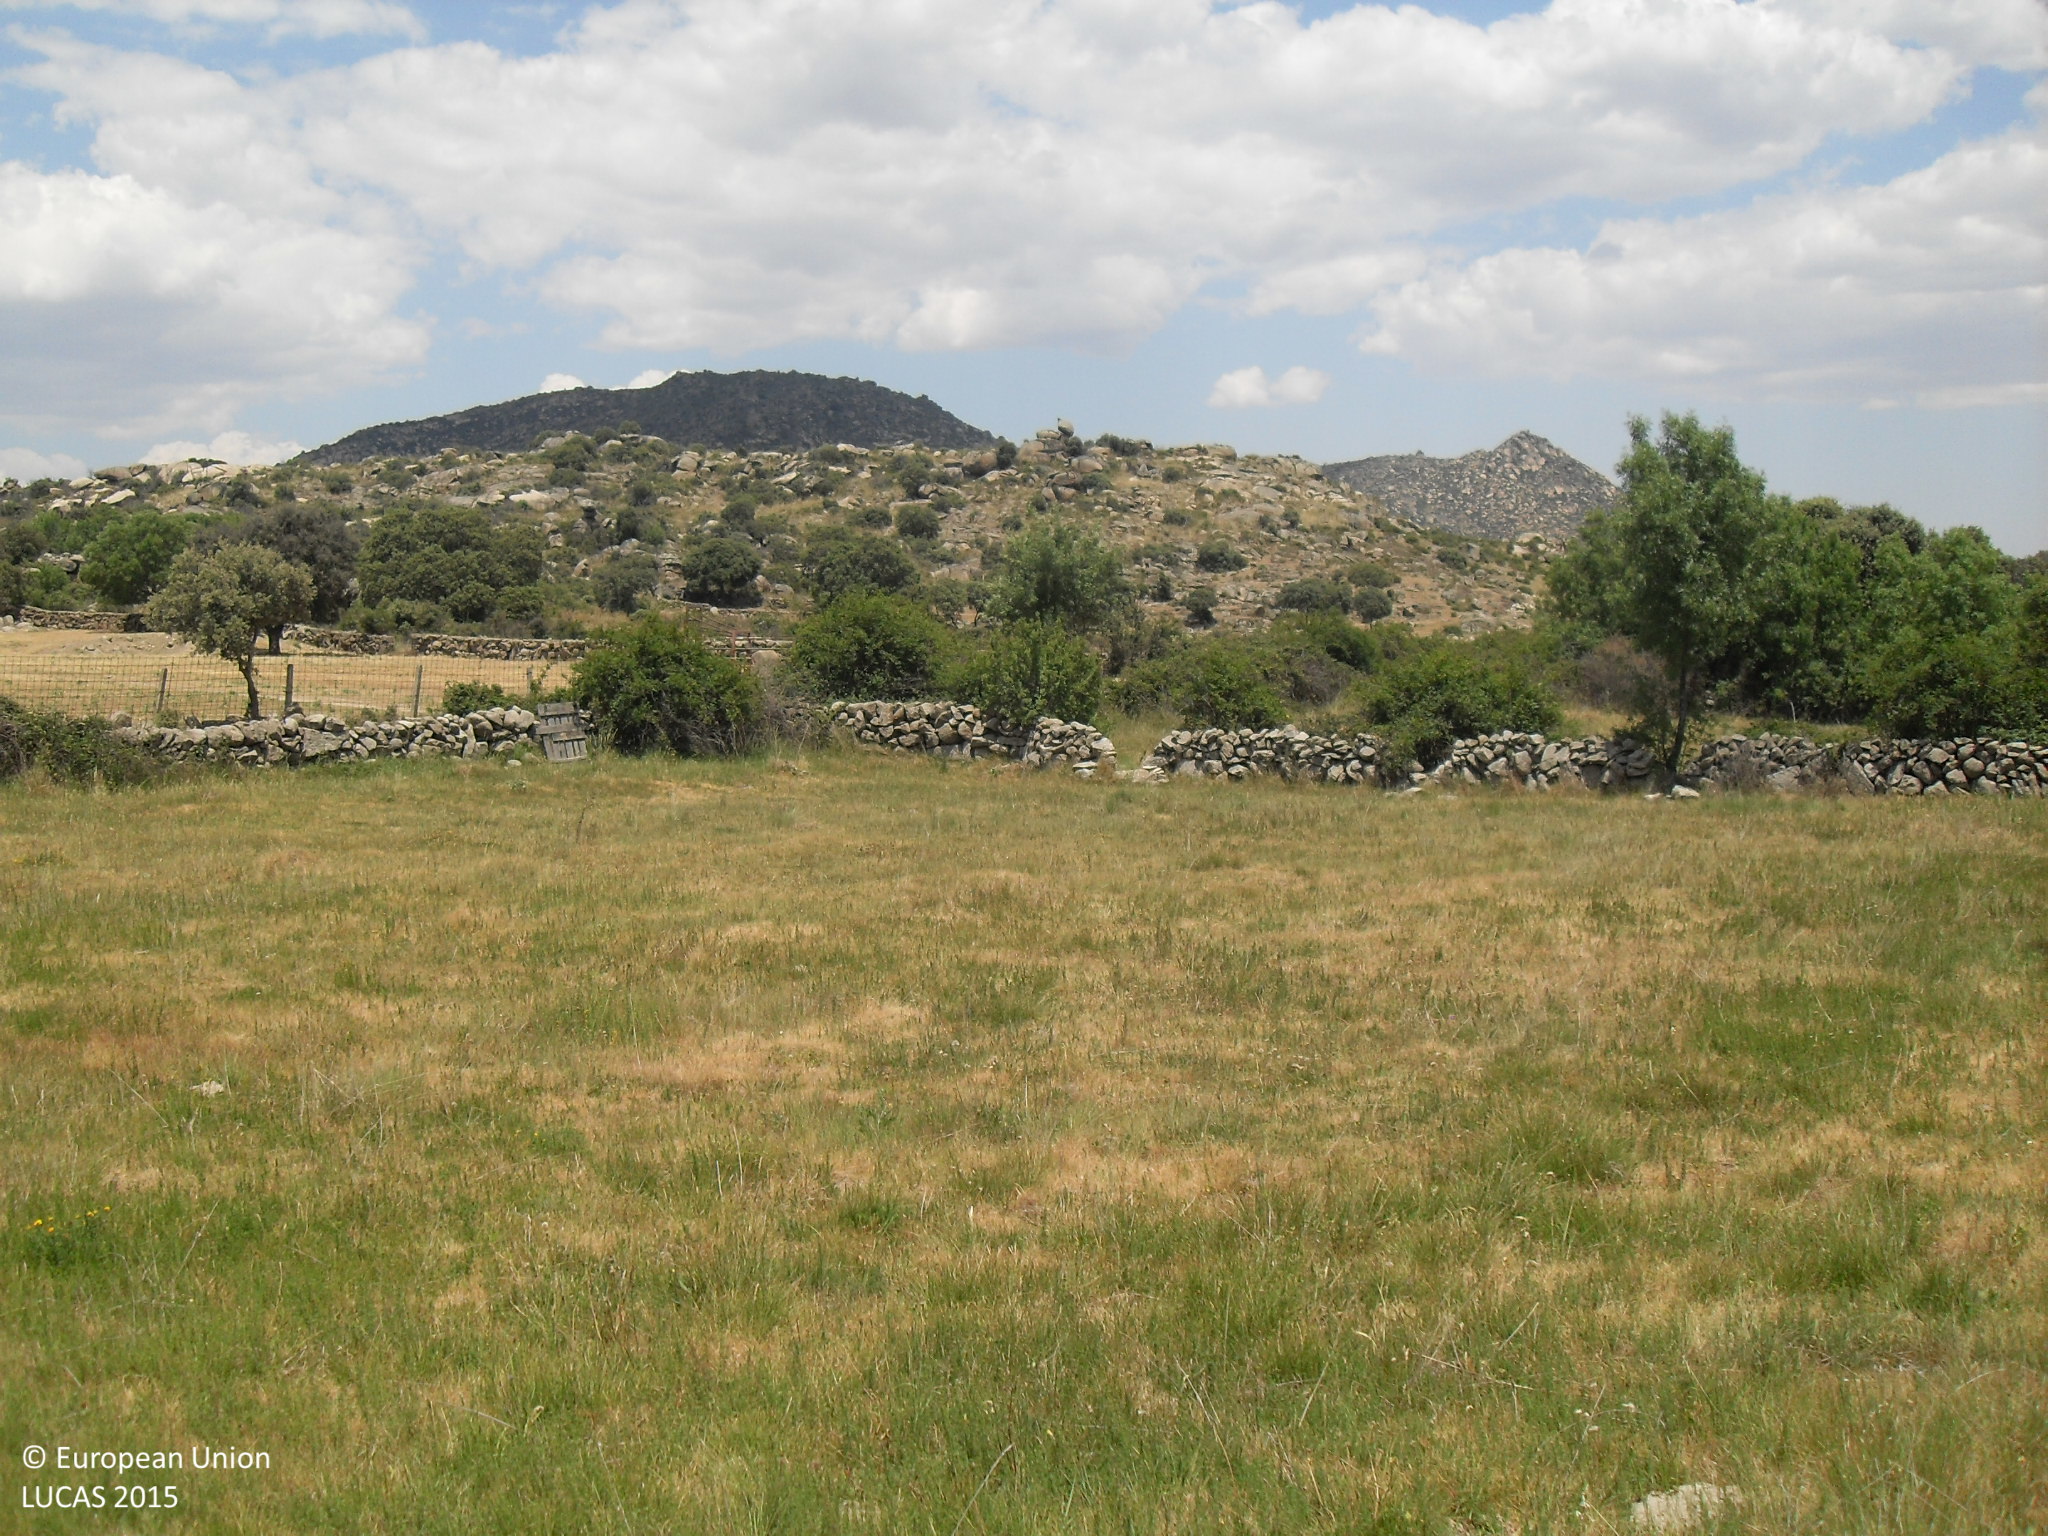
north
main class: Grassland
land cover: Grassland without tree/shrub cover
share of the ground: > 75 %
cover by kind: herbaceous plants 100 %
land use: Agriculture (excluding fallow land and kitchen gardens)
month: June
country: ES
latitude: 40.4351
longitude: -5.5454
